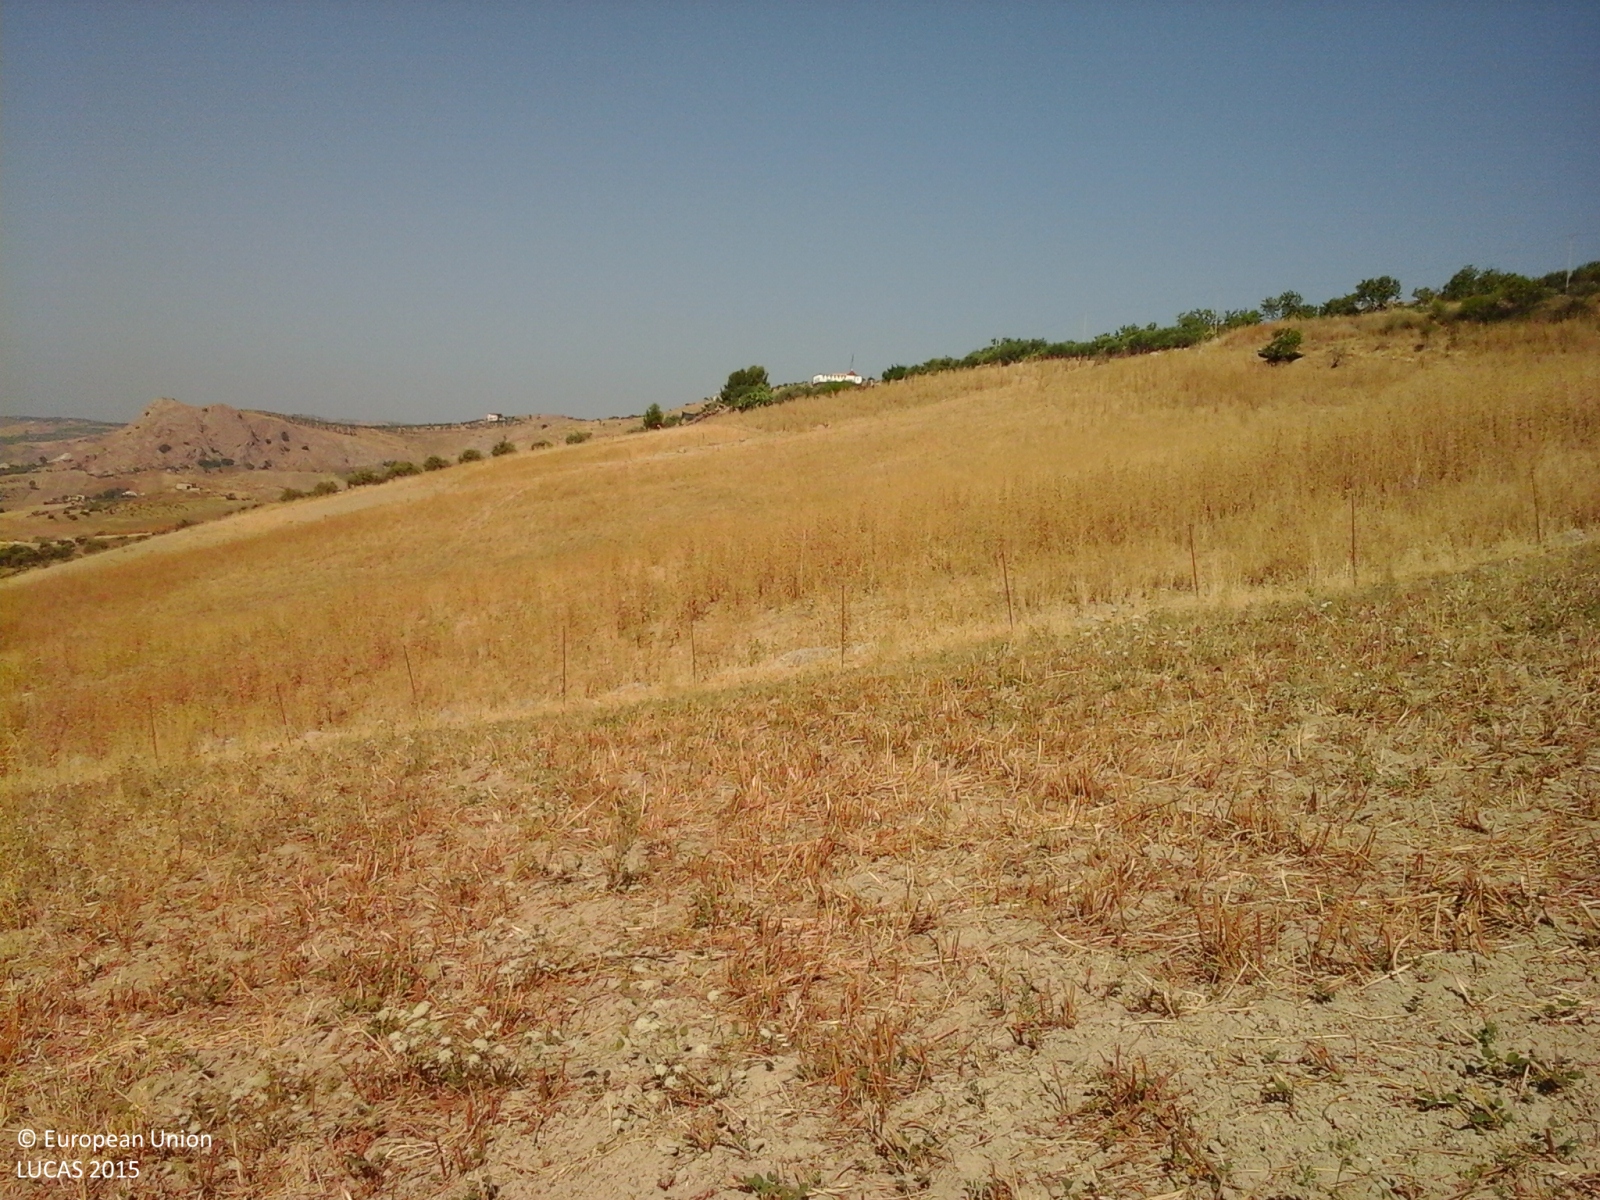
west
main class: Cropland
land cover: Lucerne
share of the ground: > 75 %
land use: Agriculture (excluding fallow land and kitchen gardens)
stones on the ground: < 10 %
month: July
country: IT
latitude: 37.4110
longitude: 13.4868
